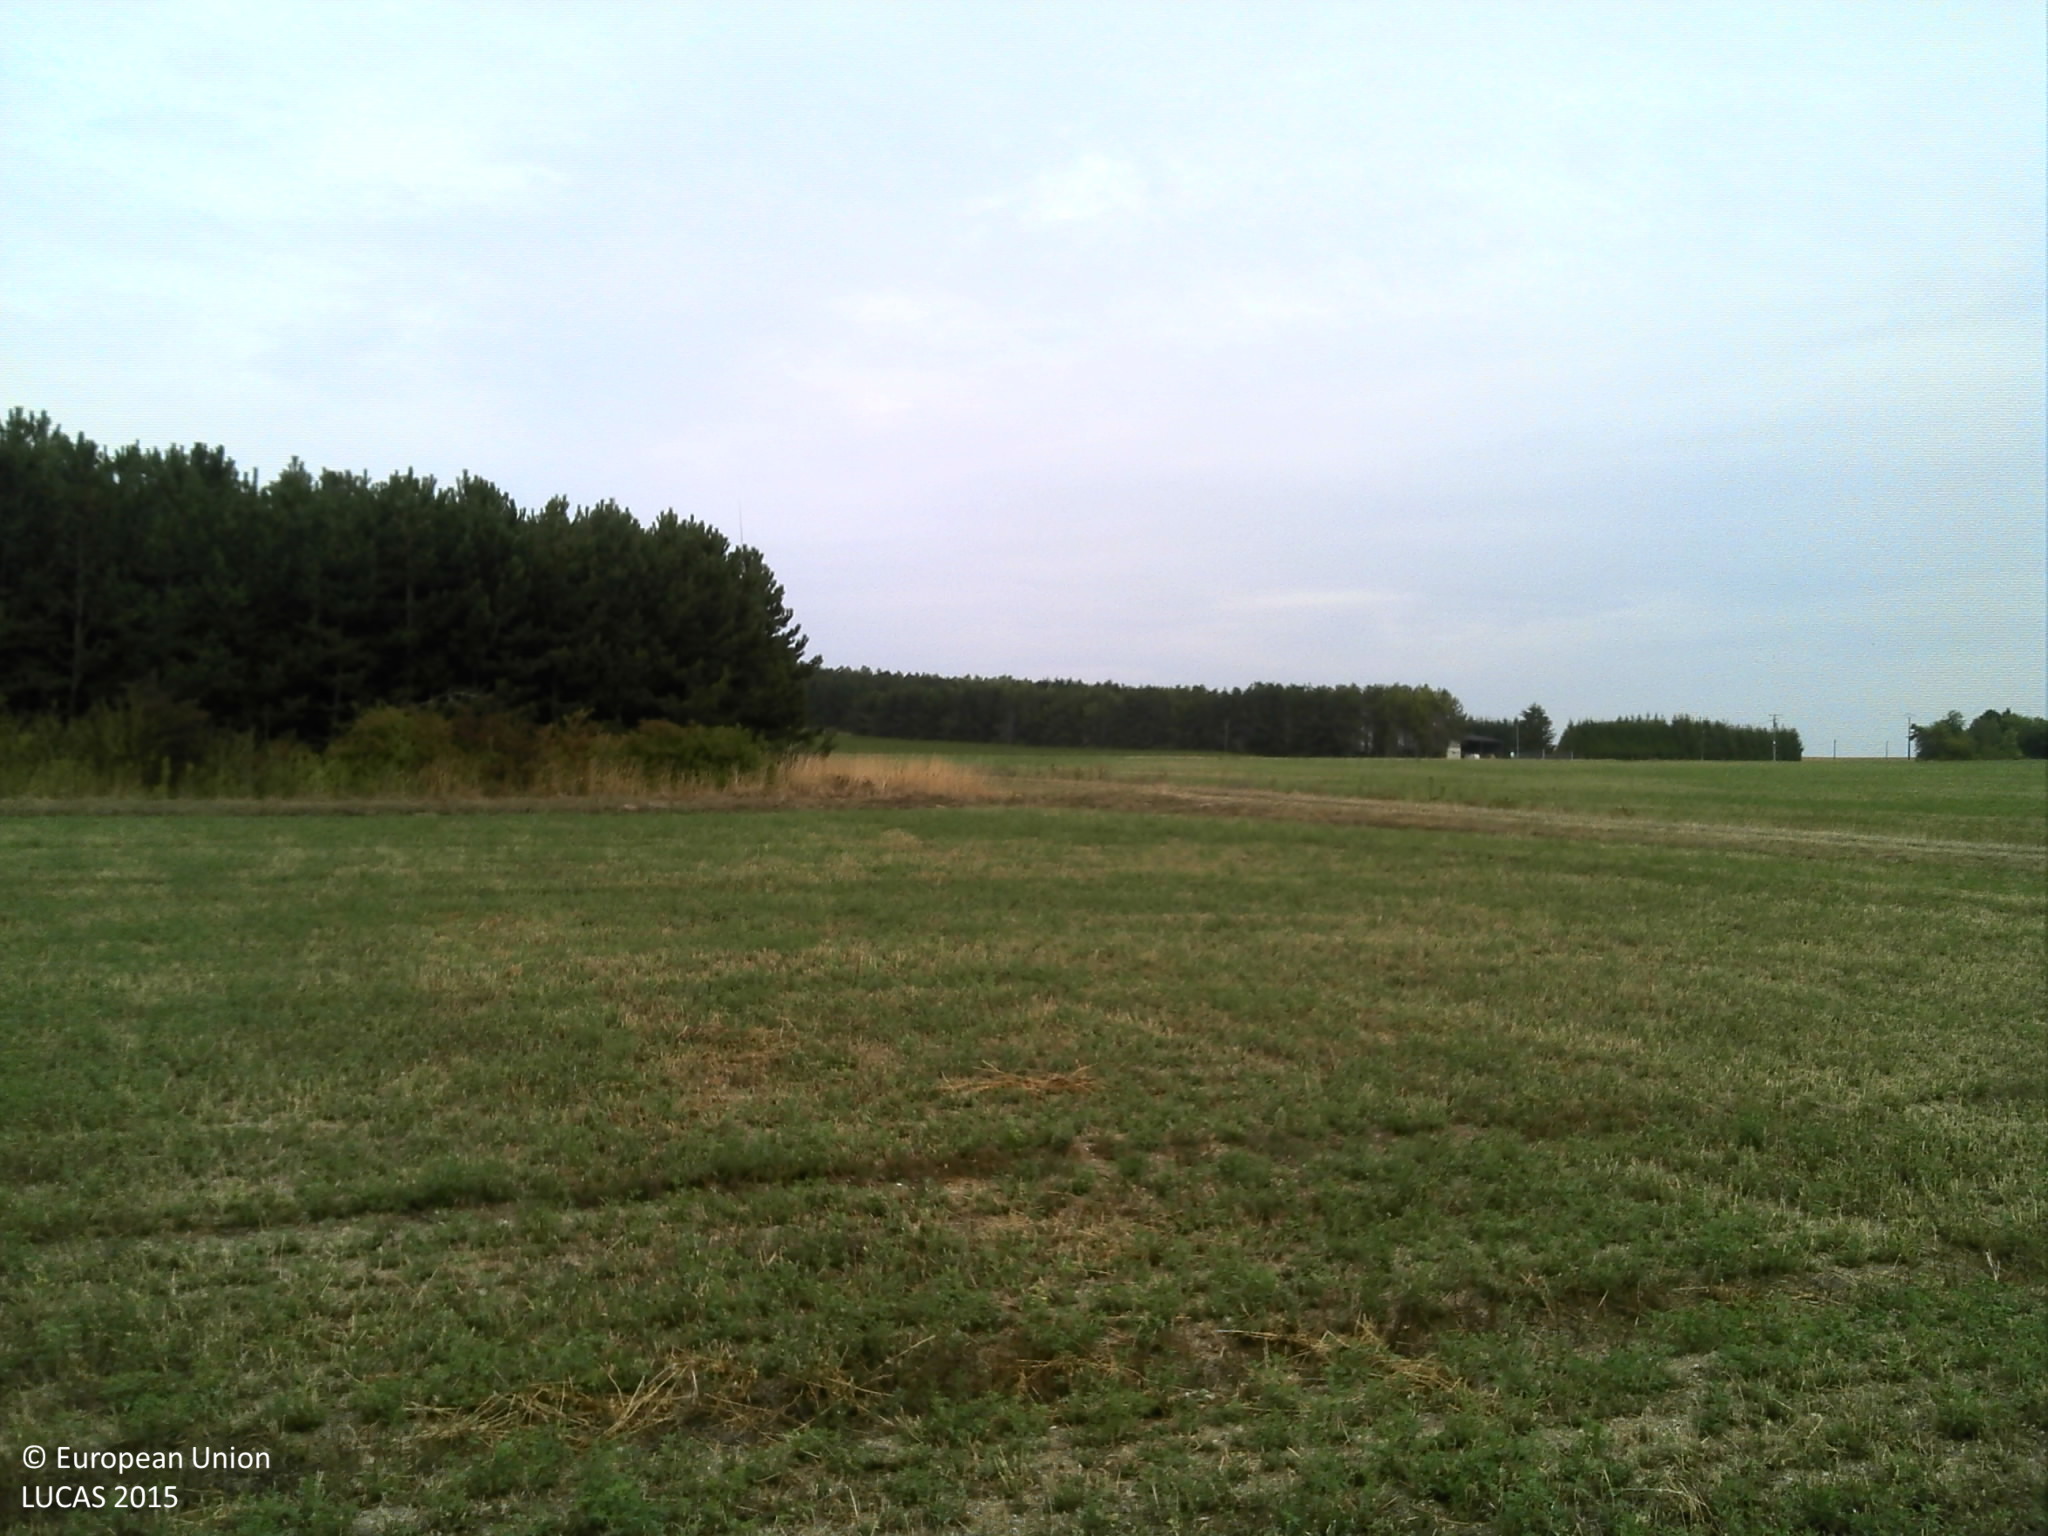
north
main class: Cropland
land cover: Lucerne
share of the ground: > 75 %
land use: Agriculture (excluding fallow land and kitchen gardens)
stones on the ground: 10 - 25 %
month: August
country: FR
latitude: 48.4316
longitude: 4.1983
